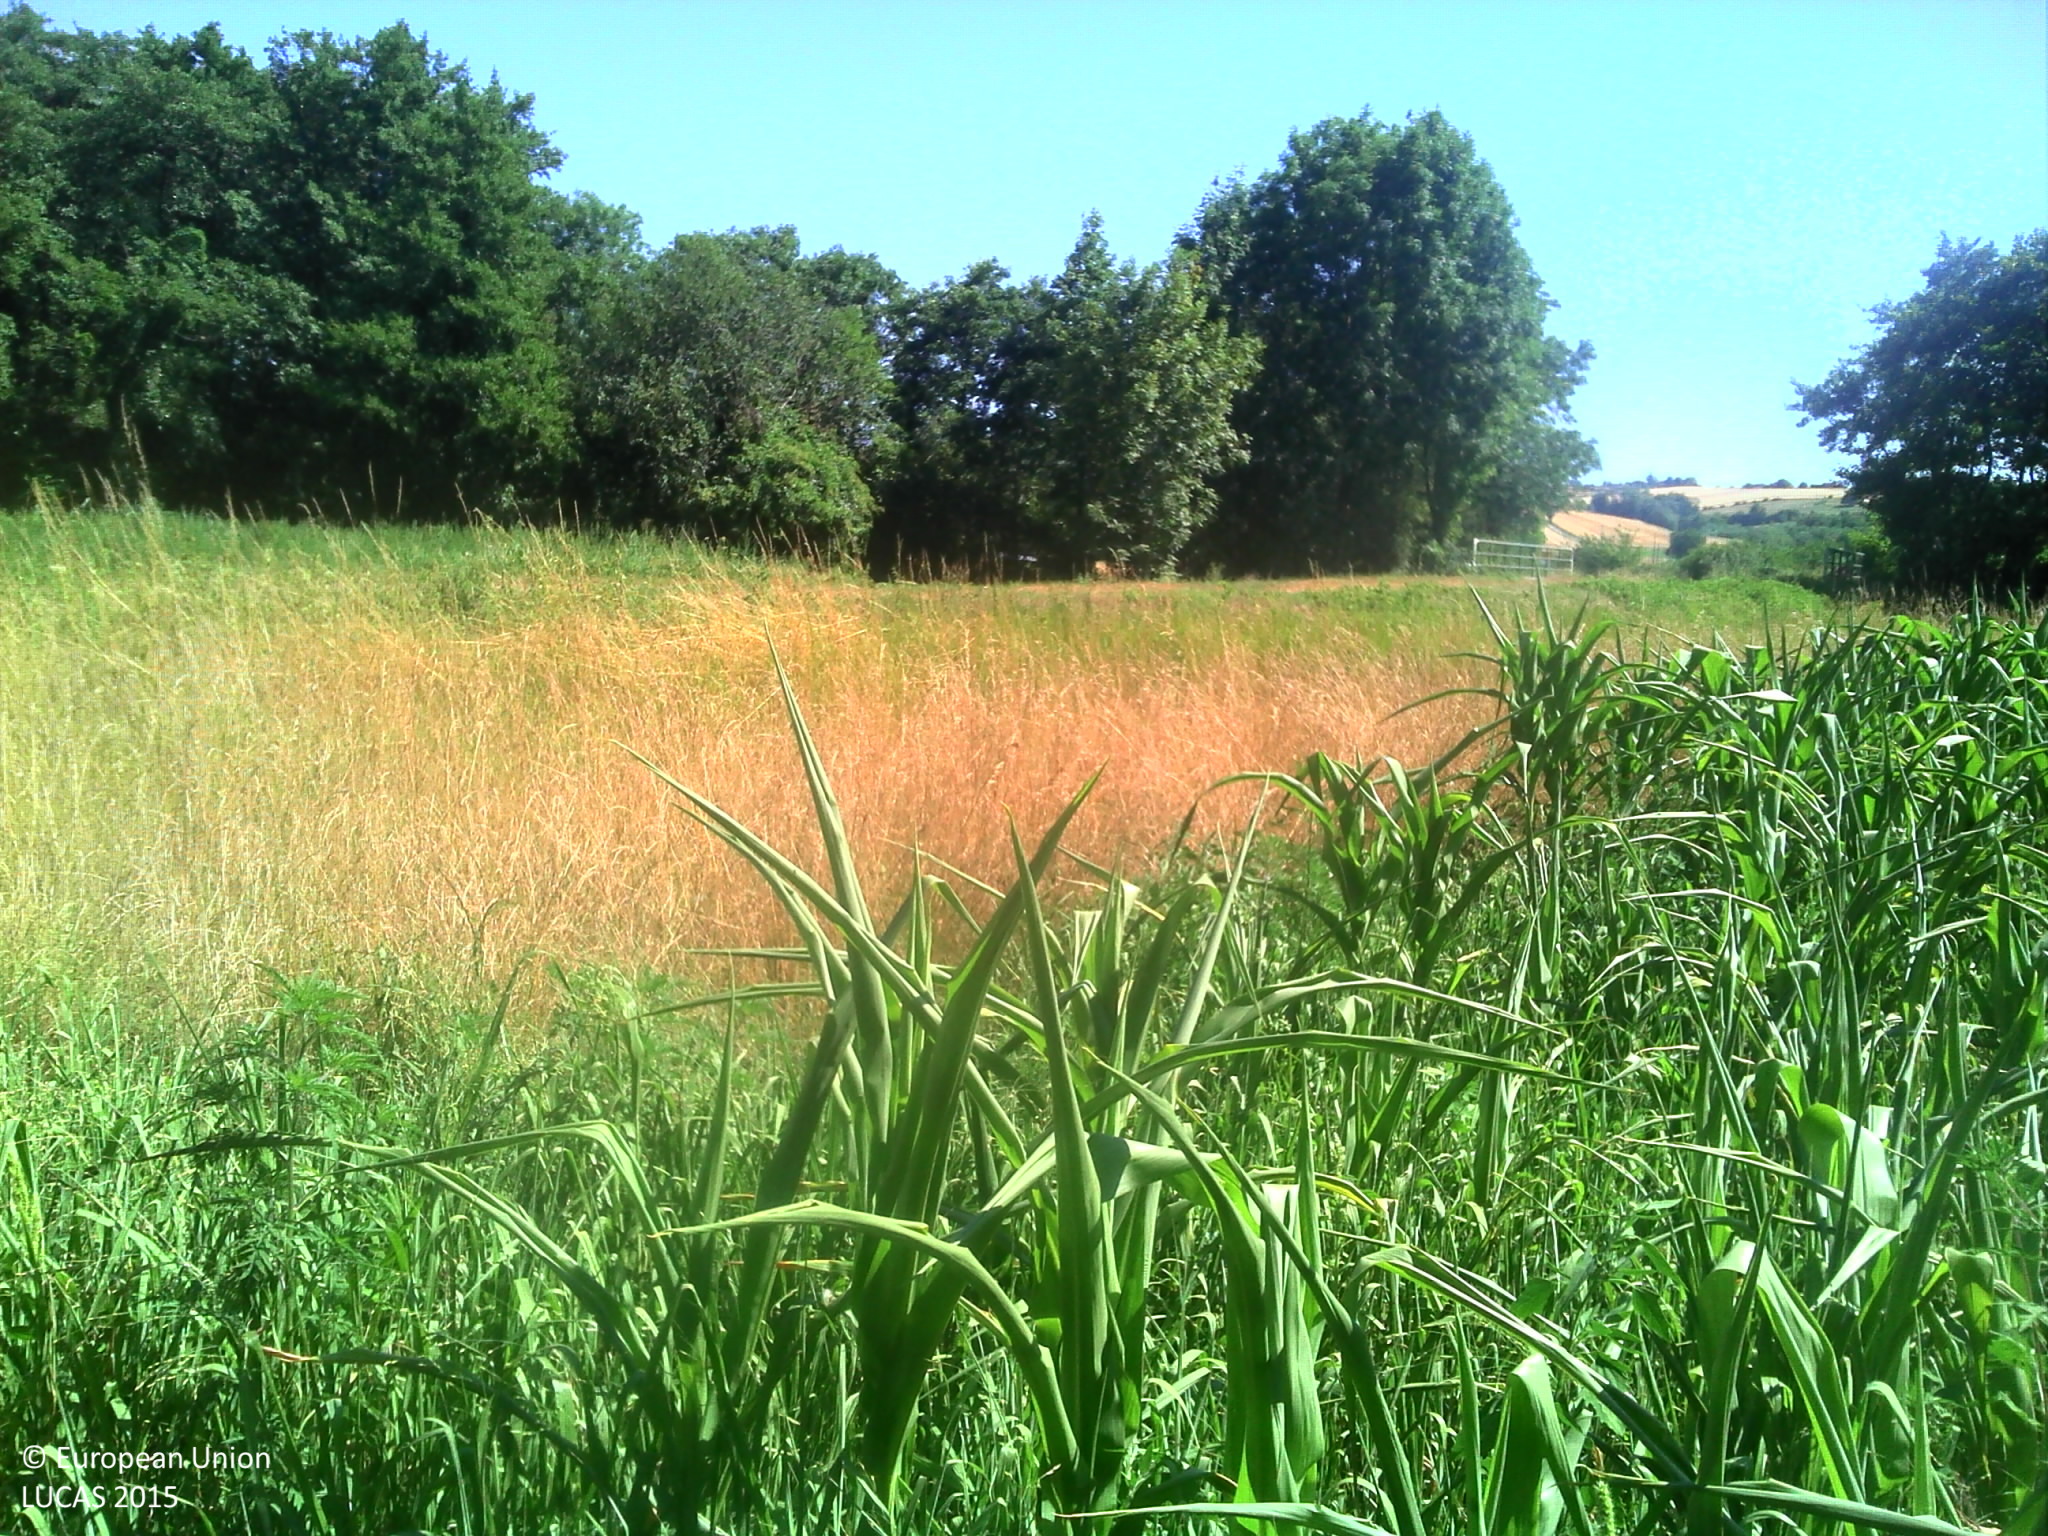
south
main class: Woodland
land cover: Broadleaved woodland
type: non-riverine alder, birch or aspen forest
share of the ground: > 75 %
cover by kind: broadleaved forest trees 75 %, herbaceous plants 25 %
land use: Forestry
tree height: > 5 m
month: July
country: FR
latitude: 45.5818
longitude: 4.9417
